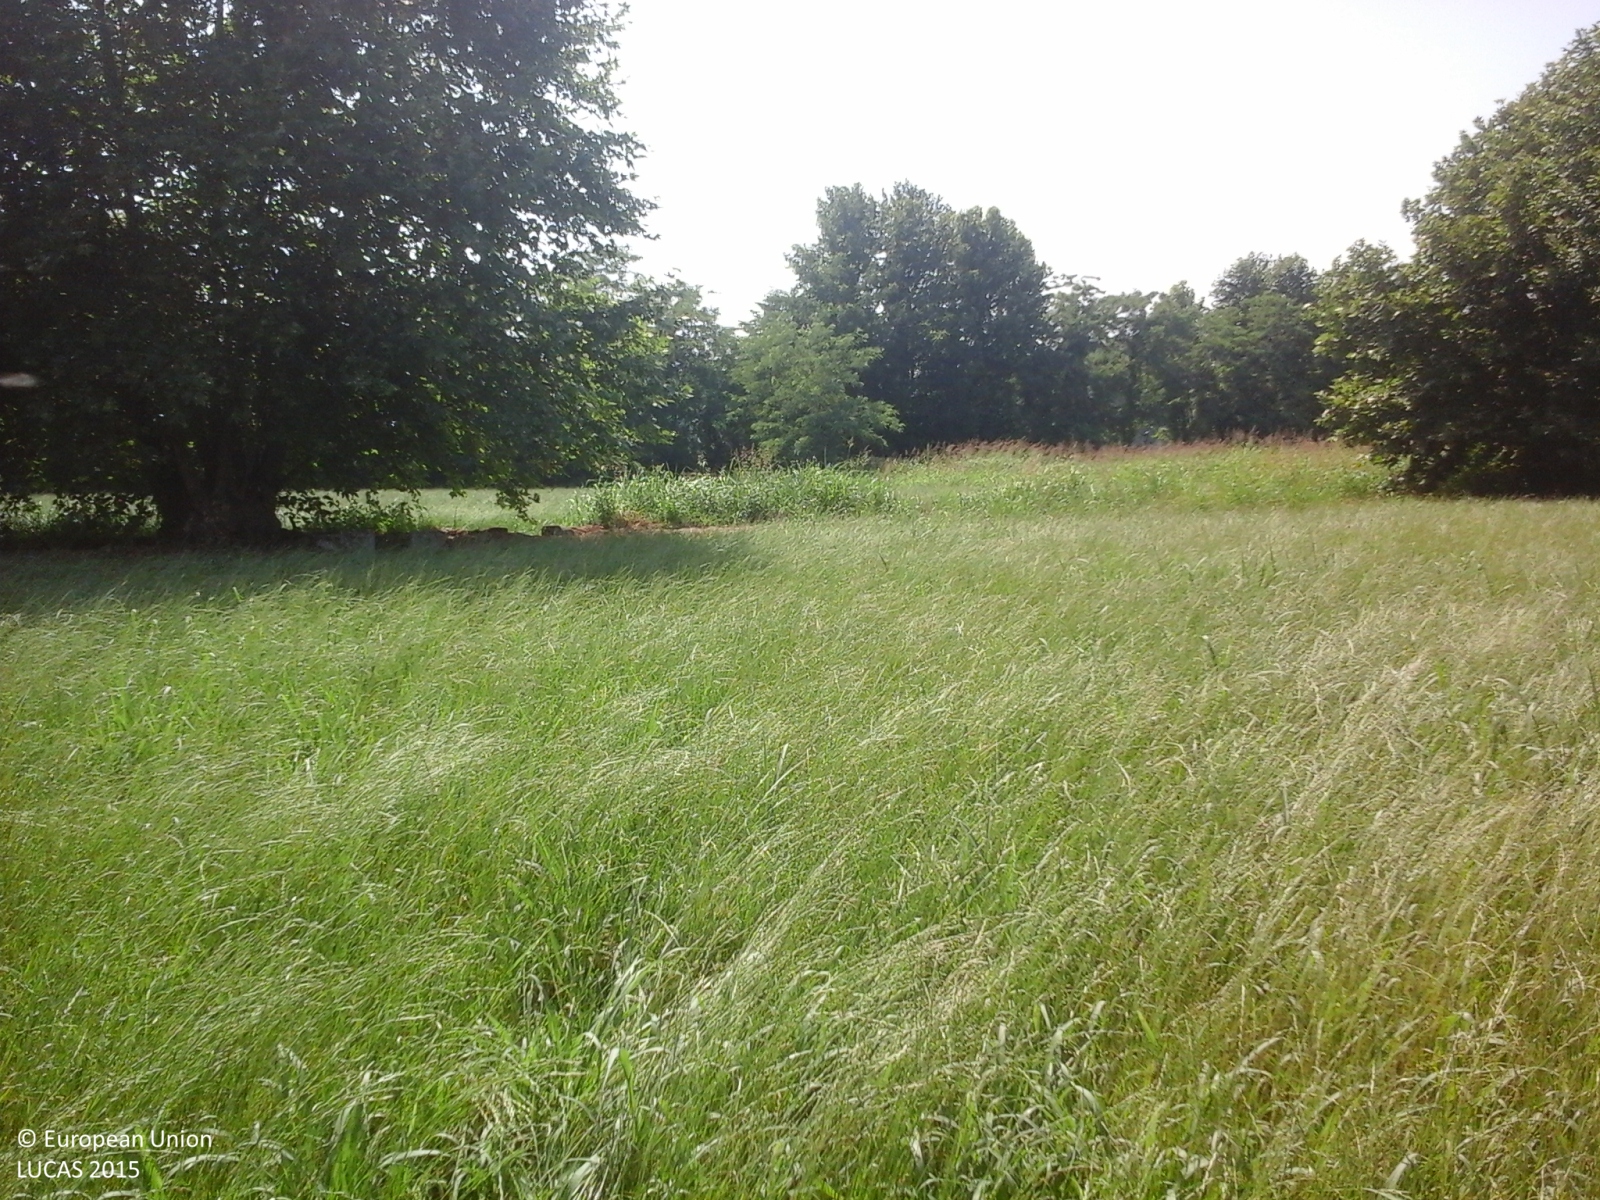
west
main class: Cropland
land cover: Temporary grasslands
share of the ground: > 75 %
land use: Agriculture (excluding fallow land and kitchen gardens)
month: July
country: IT
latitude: 45.2676
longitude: 10.7252
